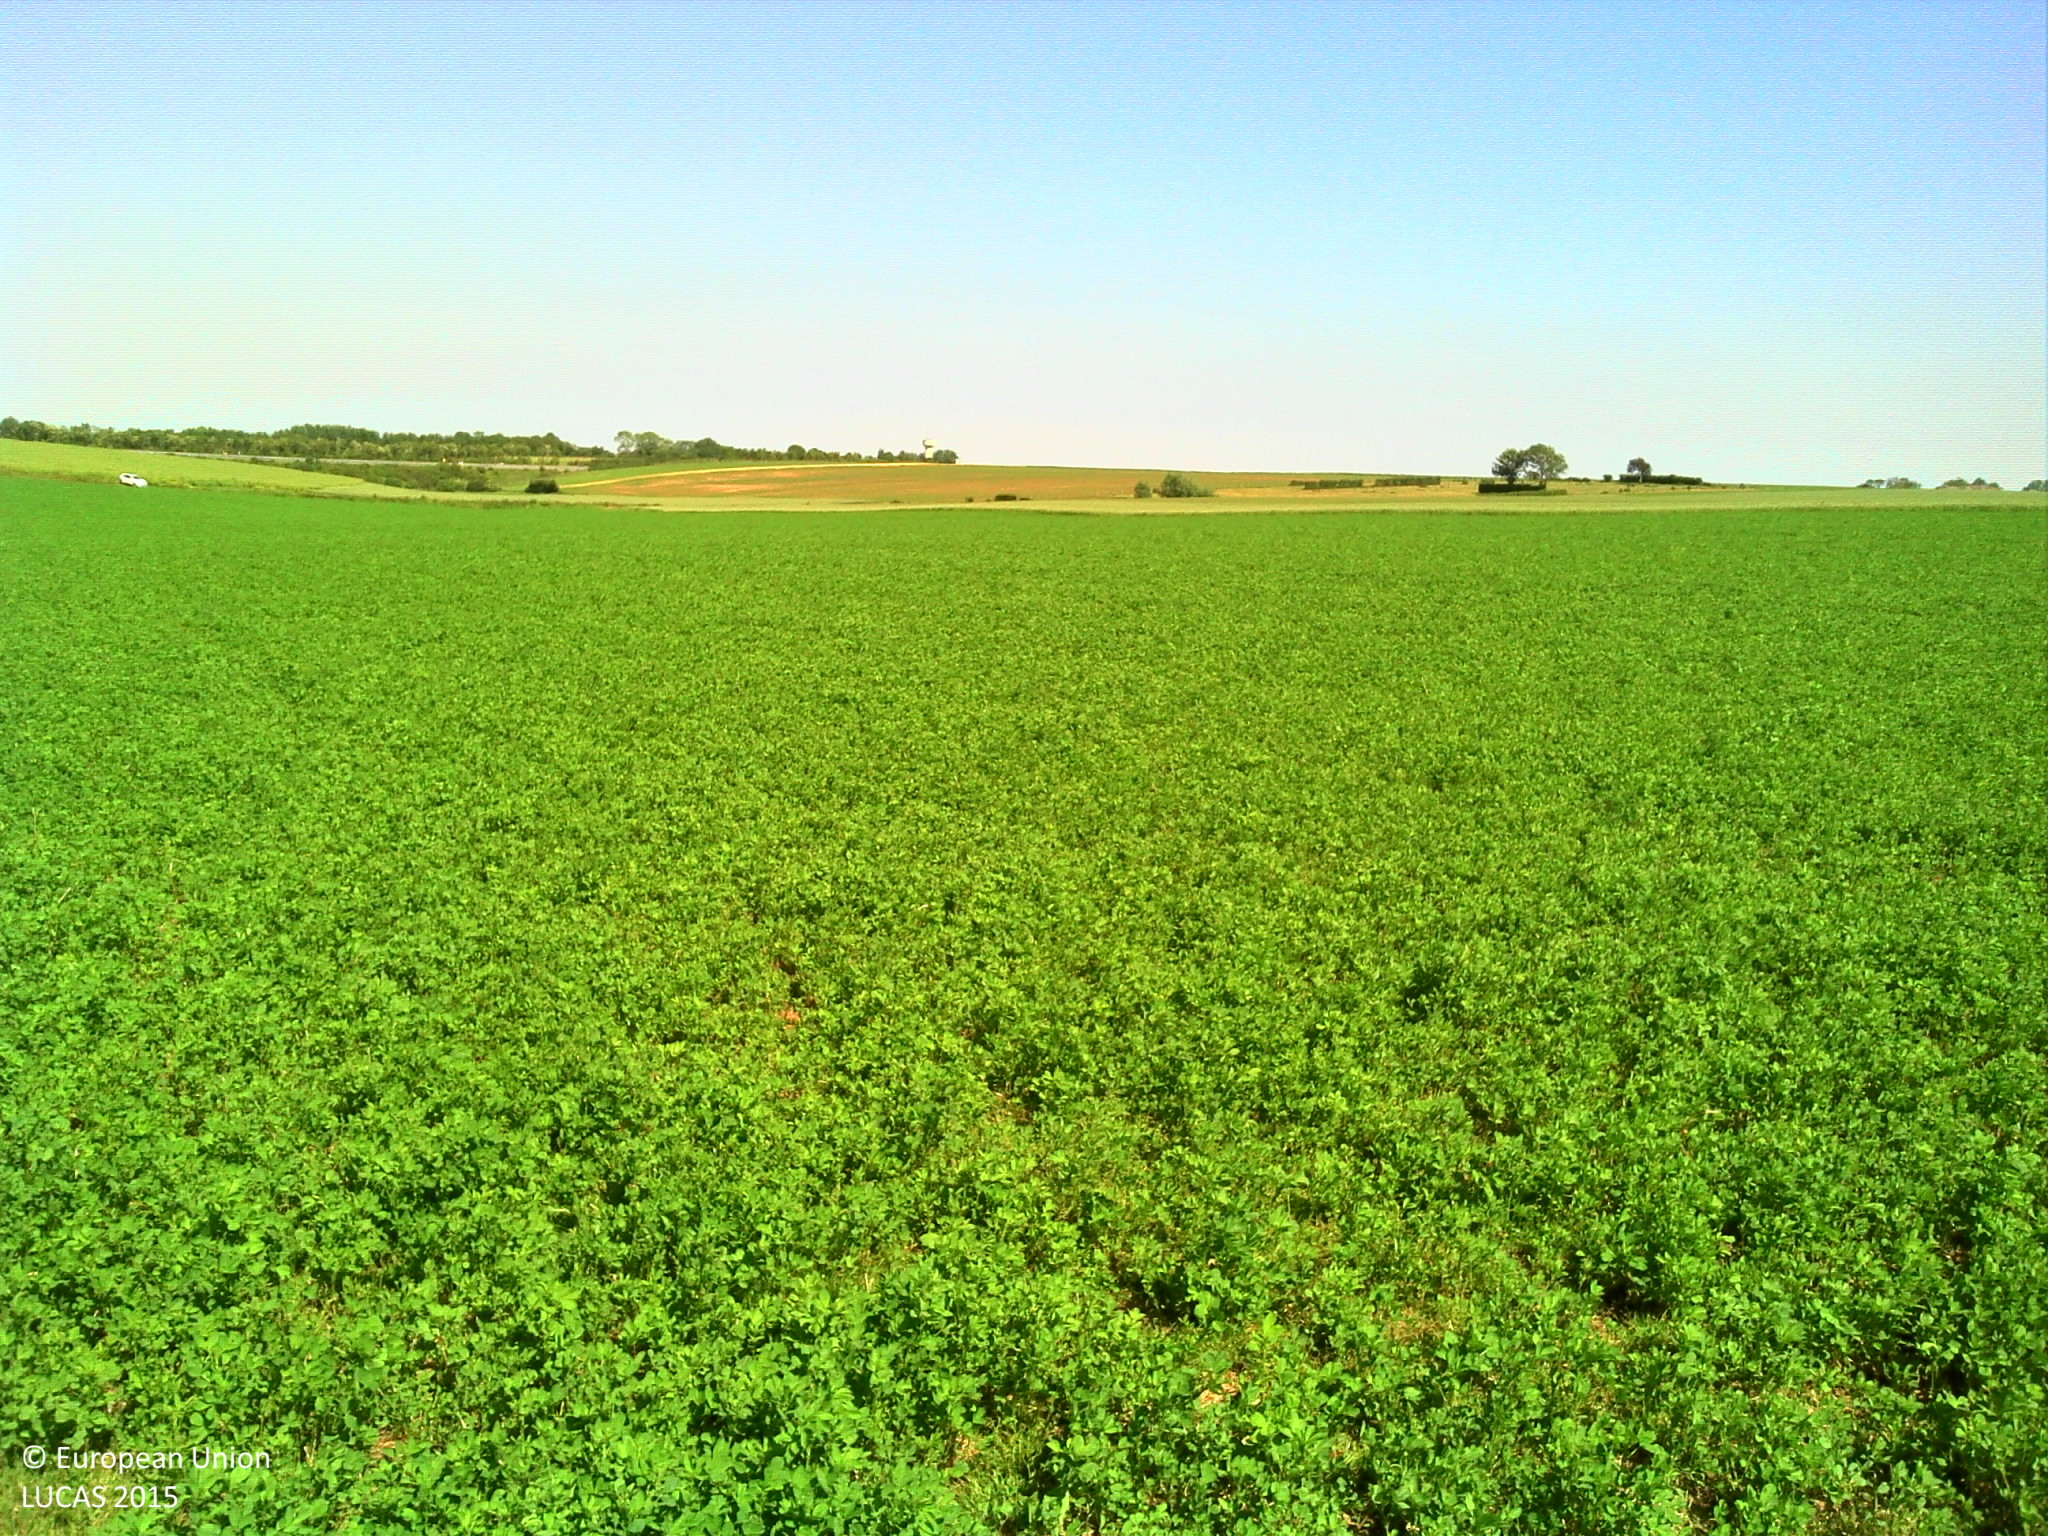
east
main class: Cropland
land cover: Lucerne
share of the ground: > 75 %
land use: Agriculture (excluding fallow land and kitchen gardens)
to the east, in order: Lucerne
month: June
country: FR
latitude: 50.7424
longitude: 2.1200
